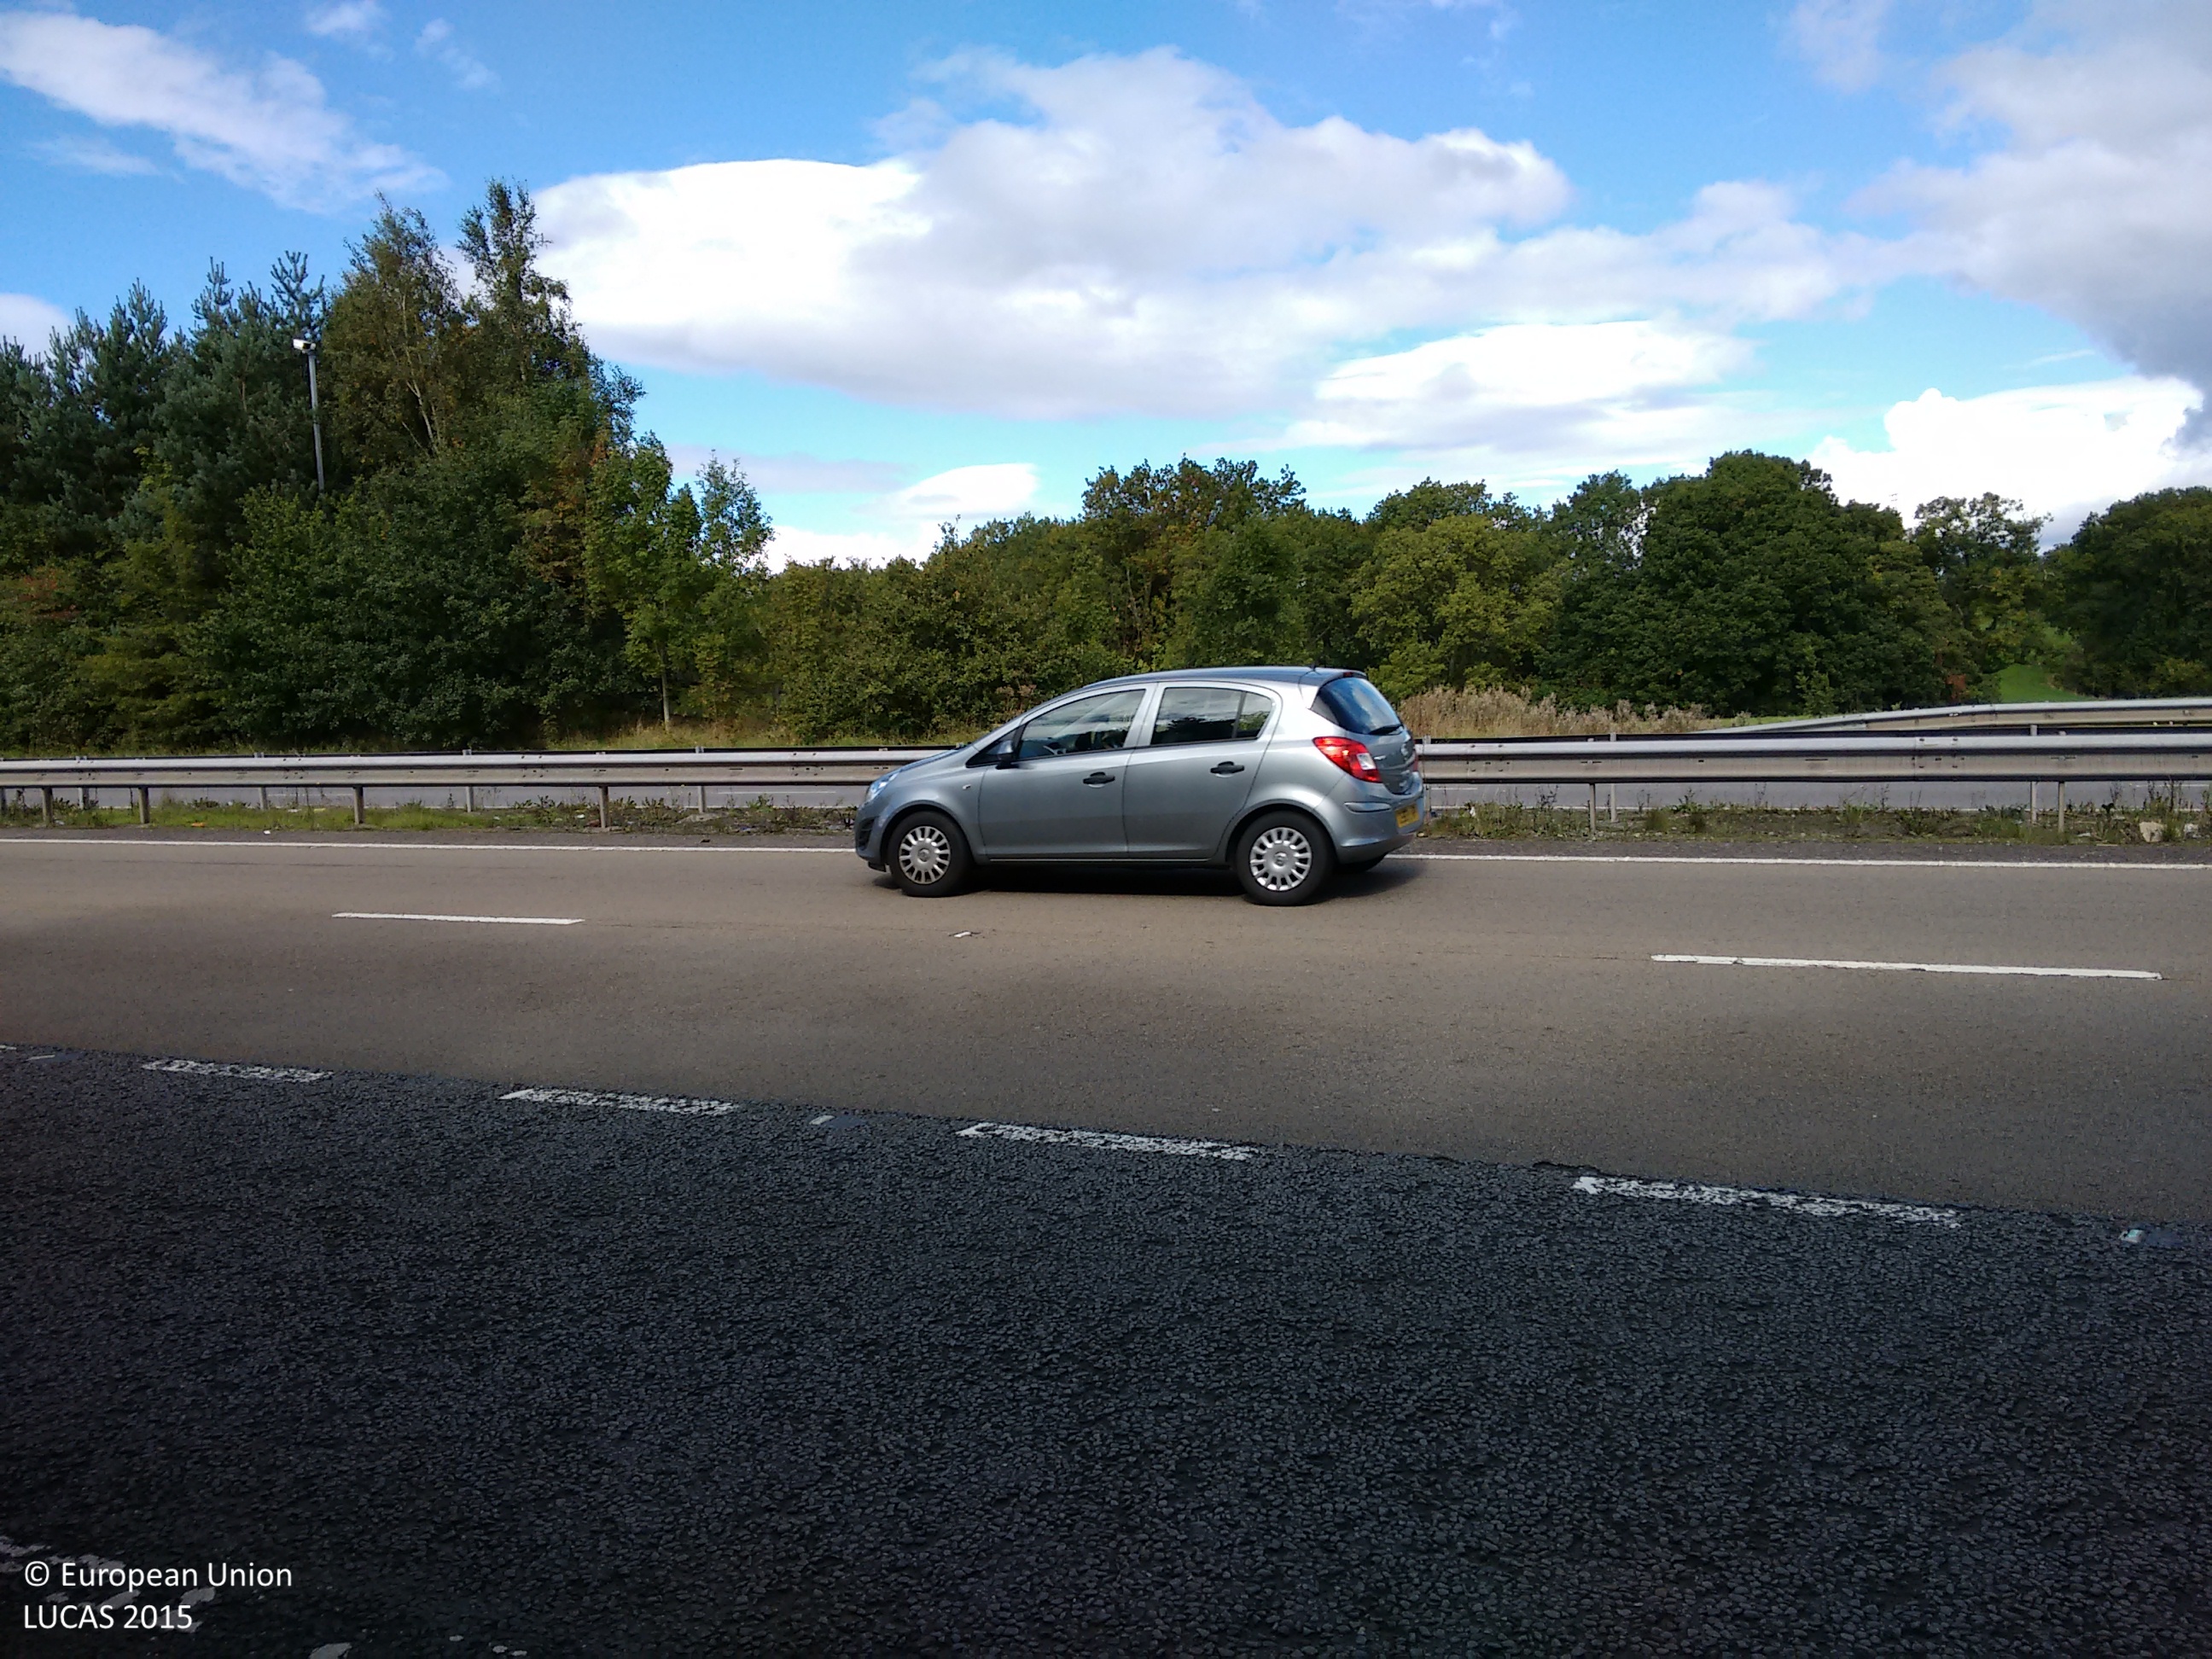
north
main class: Woodland
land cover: Broadleaved woodland
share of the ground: > 75 %
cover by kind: broadleaved forest trees 80 %, shrubs 20 %
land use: Road transport
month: September
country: GB
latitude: 51.6219
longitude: -3.0027
